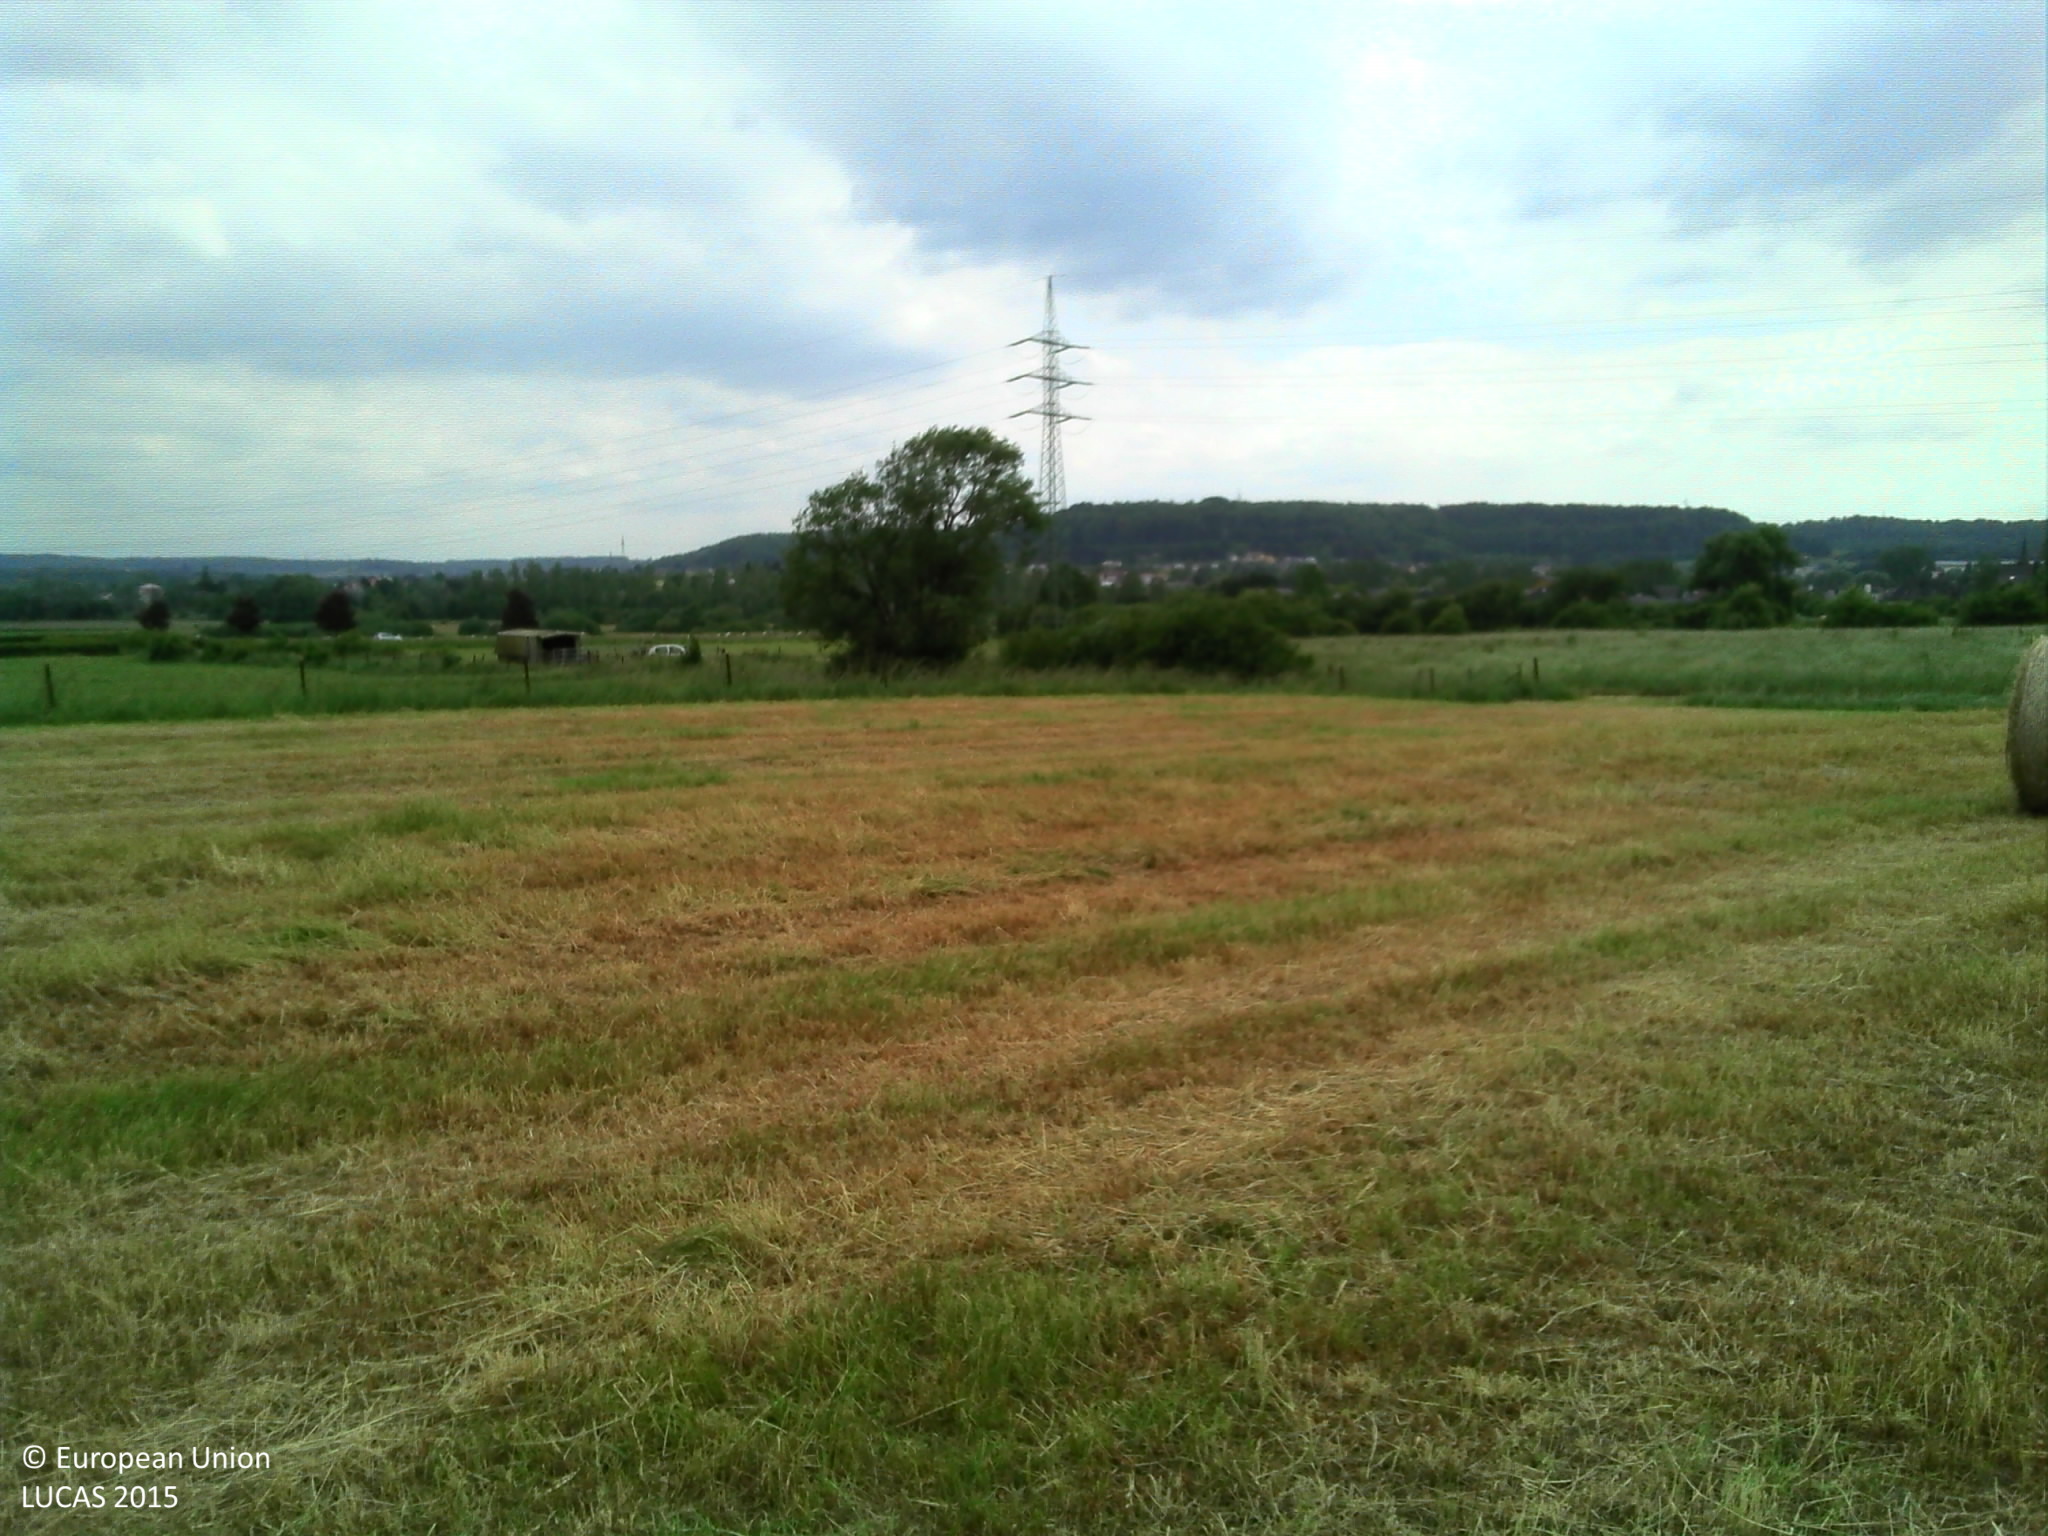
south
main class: Cropland
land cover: Temporary grasslands
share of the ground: > 75 %
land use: Agriculture (excluding fallow land and kitchen gardens)
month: June
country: LU
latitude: 49.5701
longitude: 5.8923
